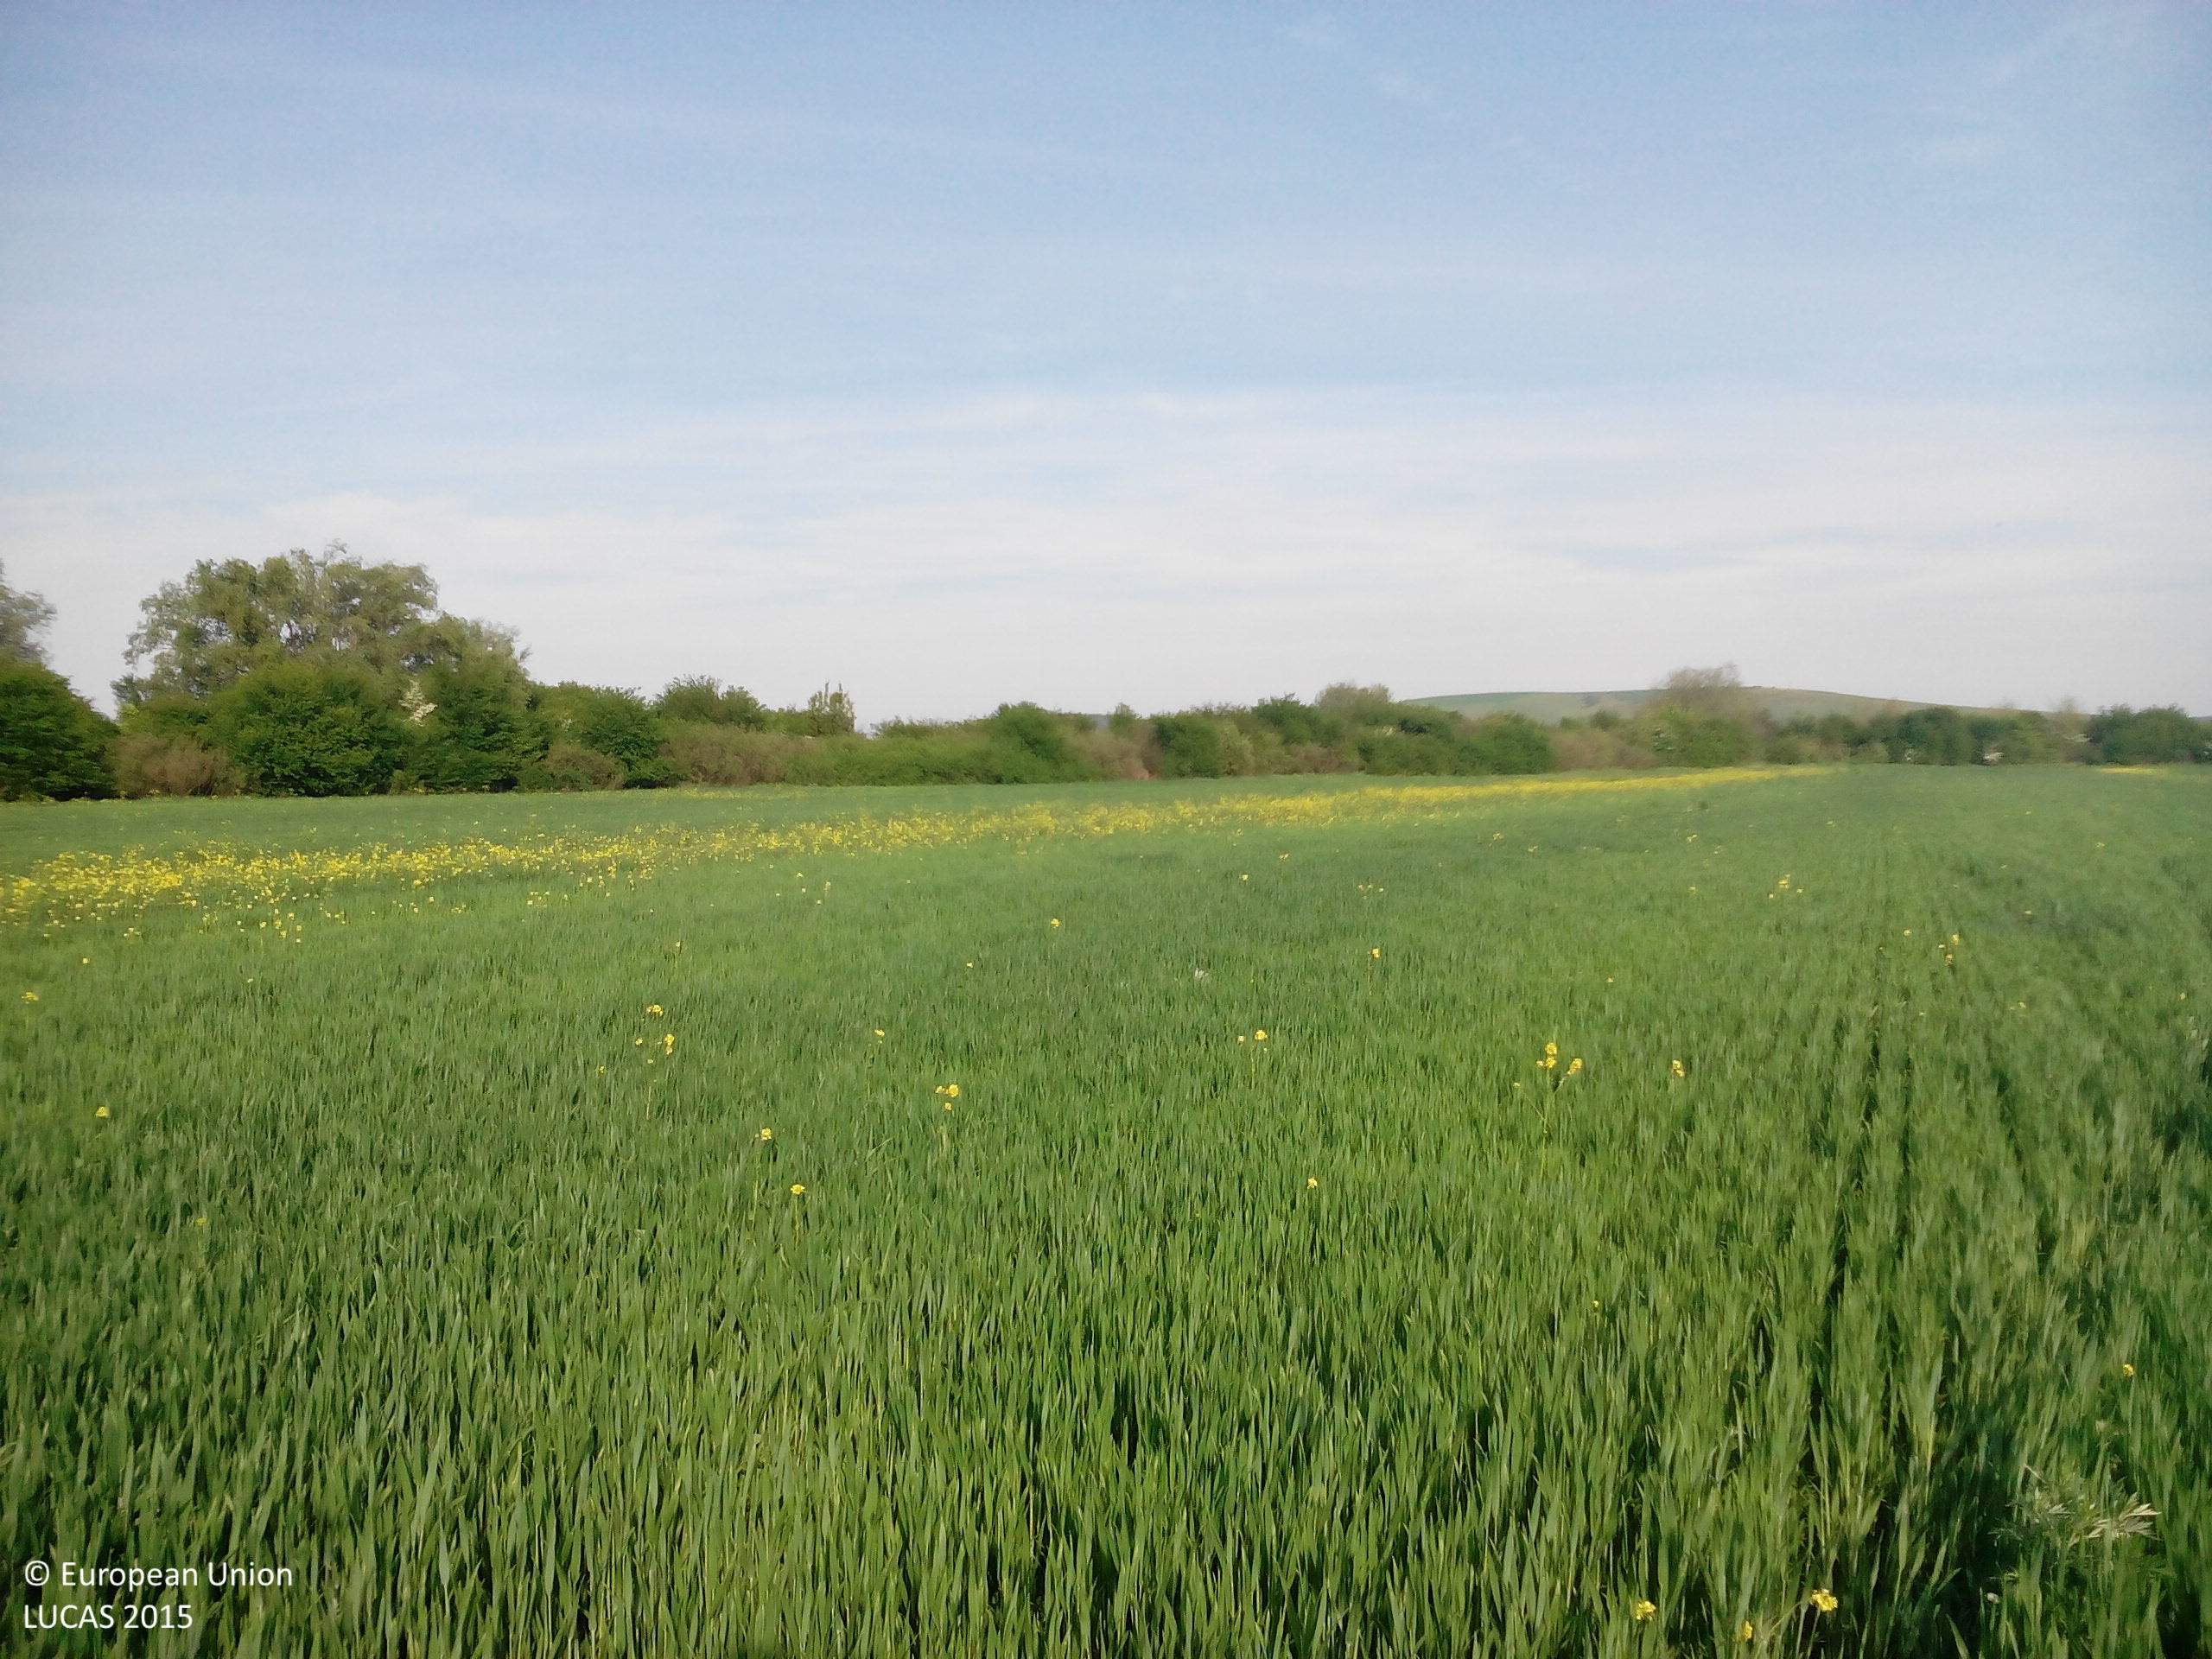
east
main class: Cropland
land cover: Common wheat
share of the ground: > 75 %
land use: Agriculture (excluding fallow land and kitchen gardens)
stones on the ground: < 10 %
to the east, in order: Common wheat; Broadleaved woodland; Ditches and canals; Broadleaved woodland; Grass margins; Sunflower; Tracks; Grass margins
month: May
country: BG
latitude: 43.7458
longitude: 23.8489
